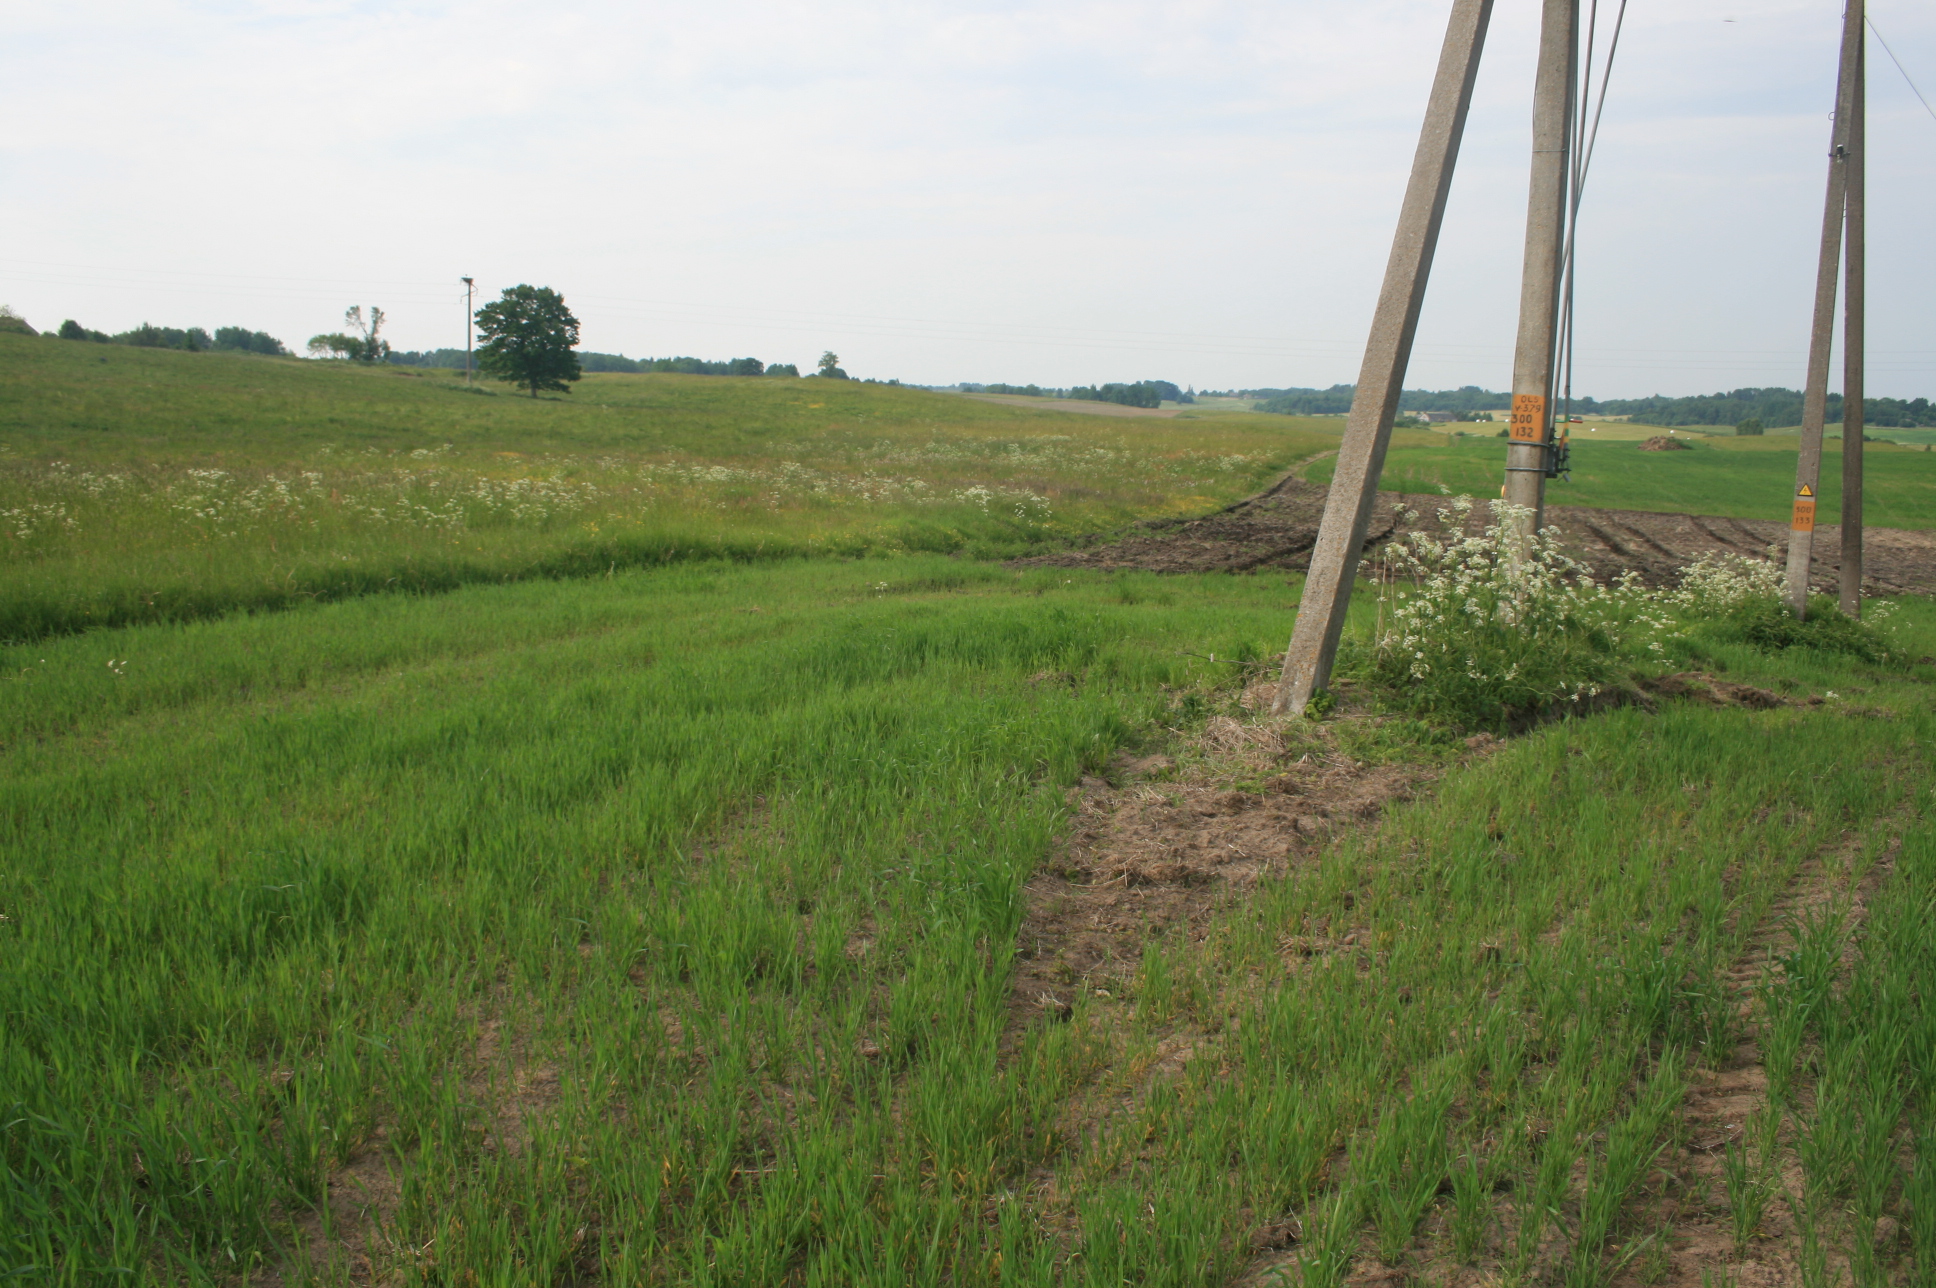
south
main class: Cropland
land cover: Common wheat
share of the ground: > 75 %
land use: Agriculture (excluding fallow land and kitchen gardens)
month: June
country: LT
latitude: 55.7415
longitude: 22.2736
